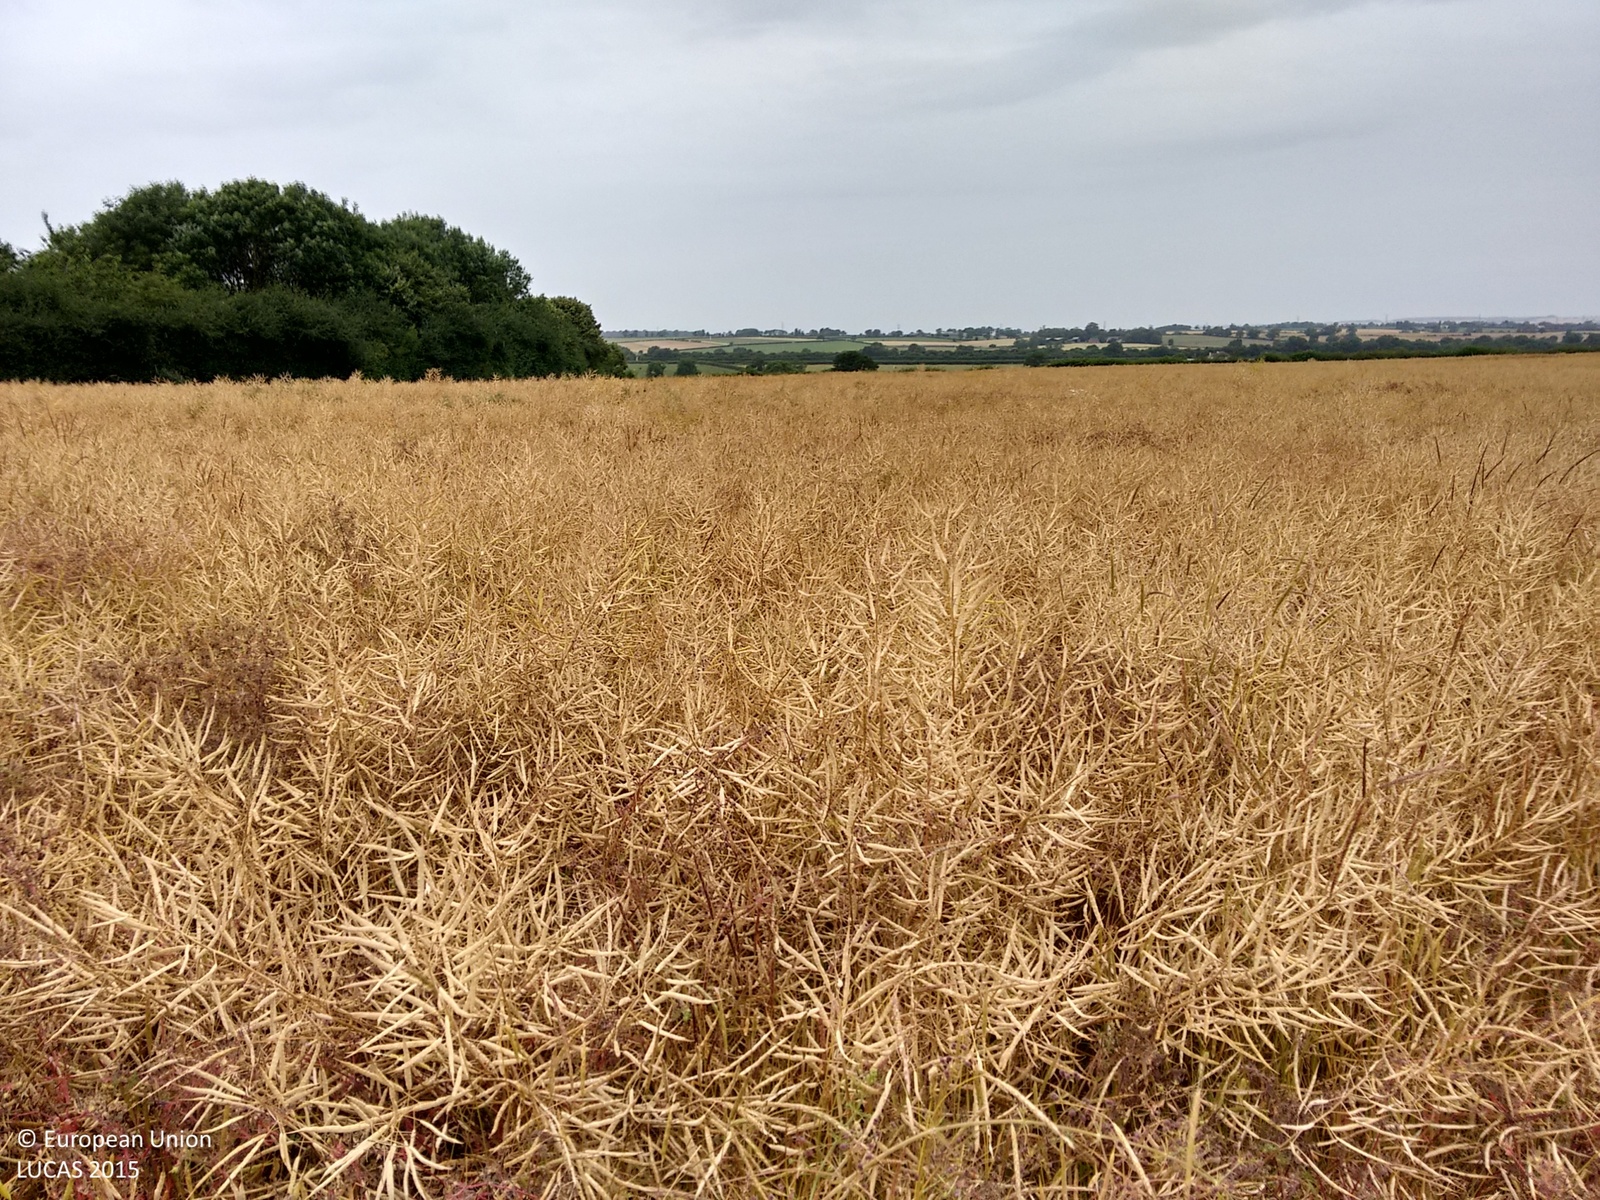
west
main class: Woodland
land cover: Broadleaved woodland
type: mesophytic deciduous forest
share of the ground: > 75 %
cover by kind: broadleaved forest trees 100 %
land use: Semi-natural and natural areas not in use
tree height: > 5 m
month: July
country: GB
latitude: 52.7272
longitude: -0.8965
